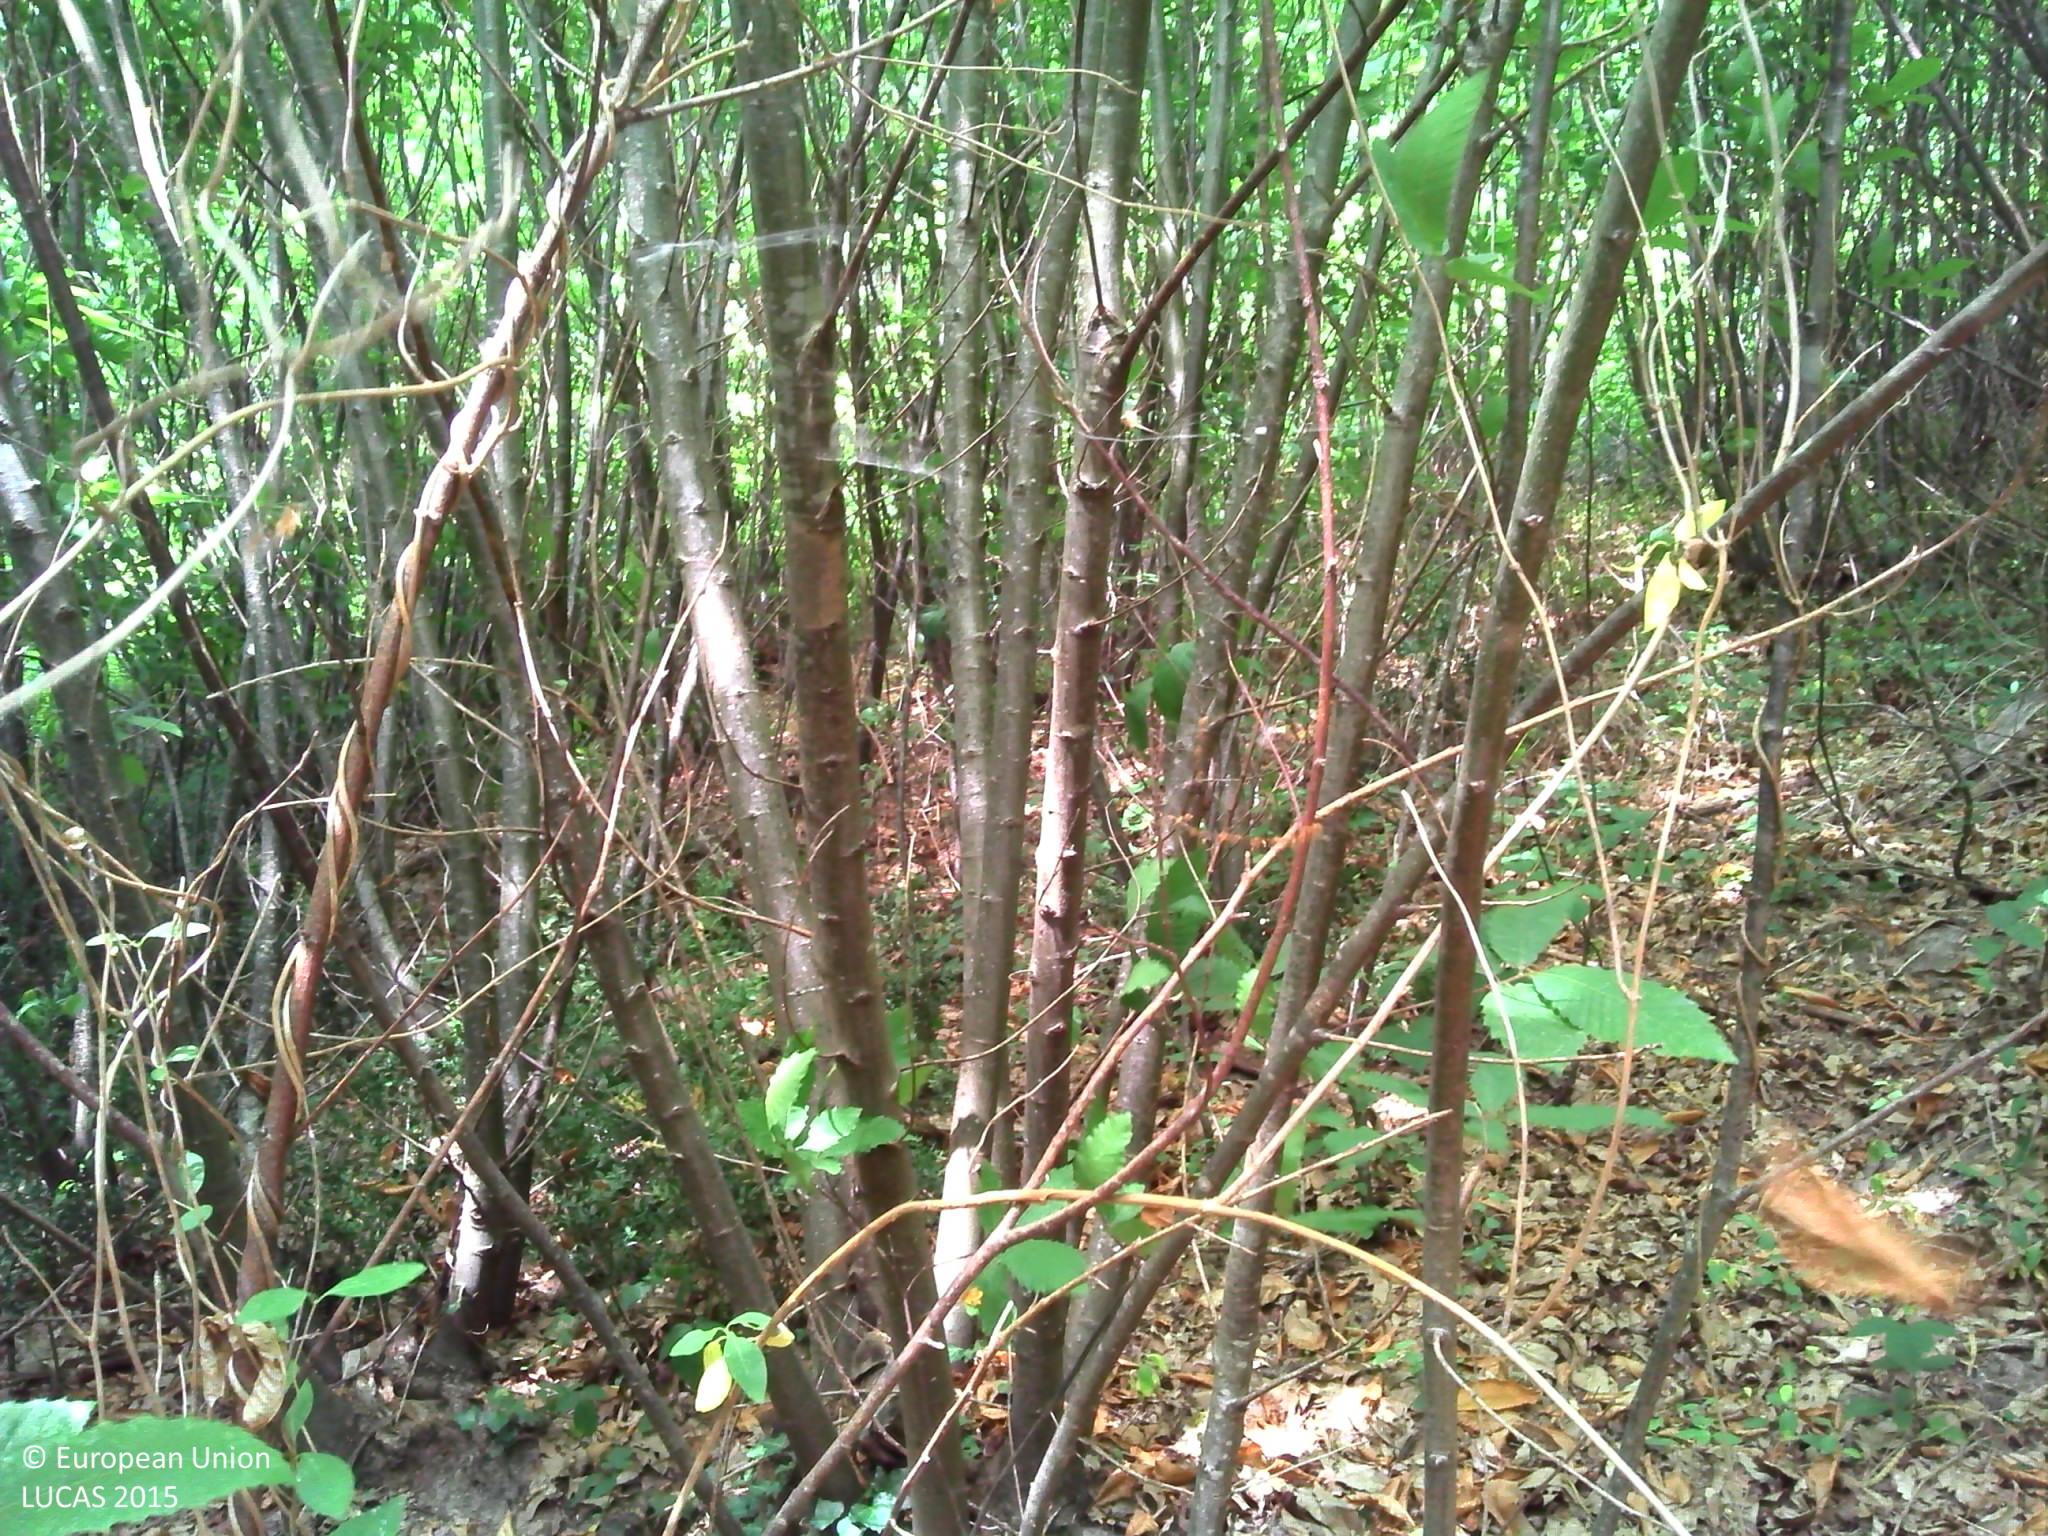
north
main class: Woodland
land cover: Broadleaved woodland
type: mesophytic deciduous forest
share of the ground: > 75 %
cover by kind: broadleaved forest trees 100 %
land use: Forestry
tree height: > 5 m
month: July
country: FR
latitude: 45.5348
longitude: 0.3689
